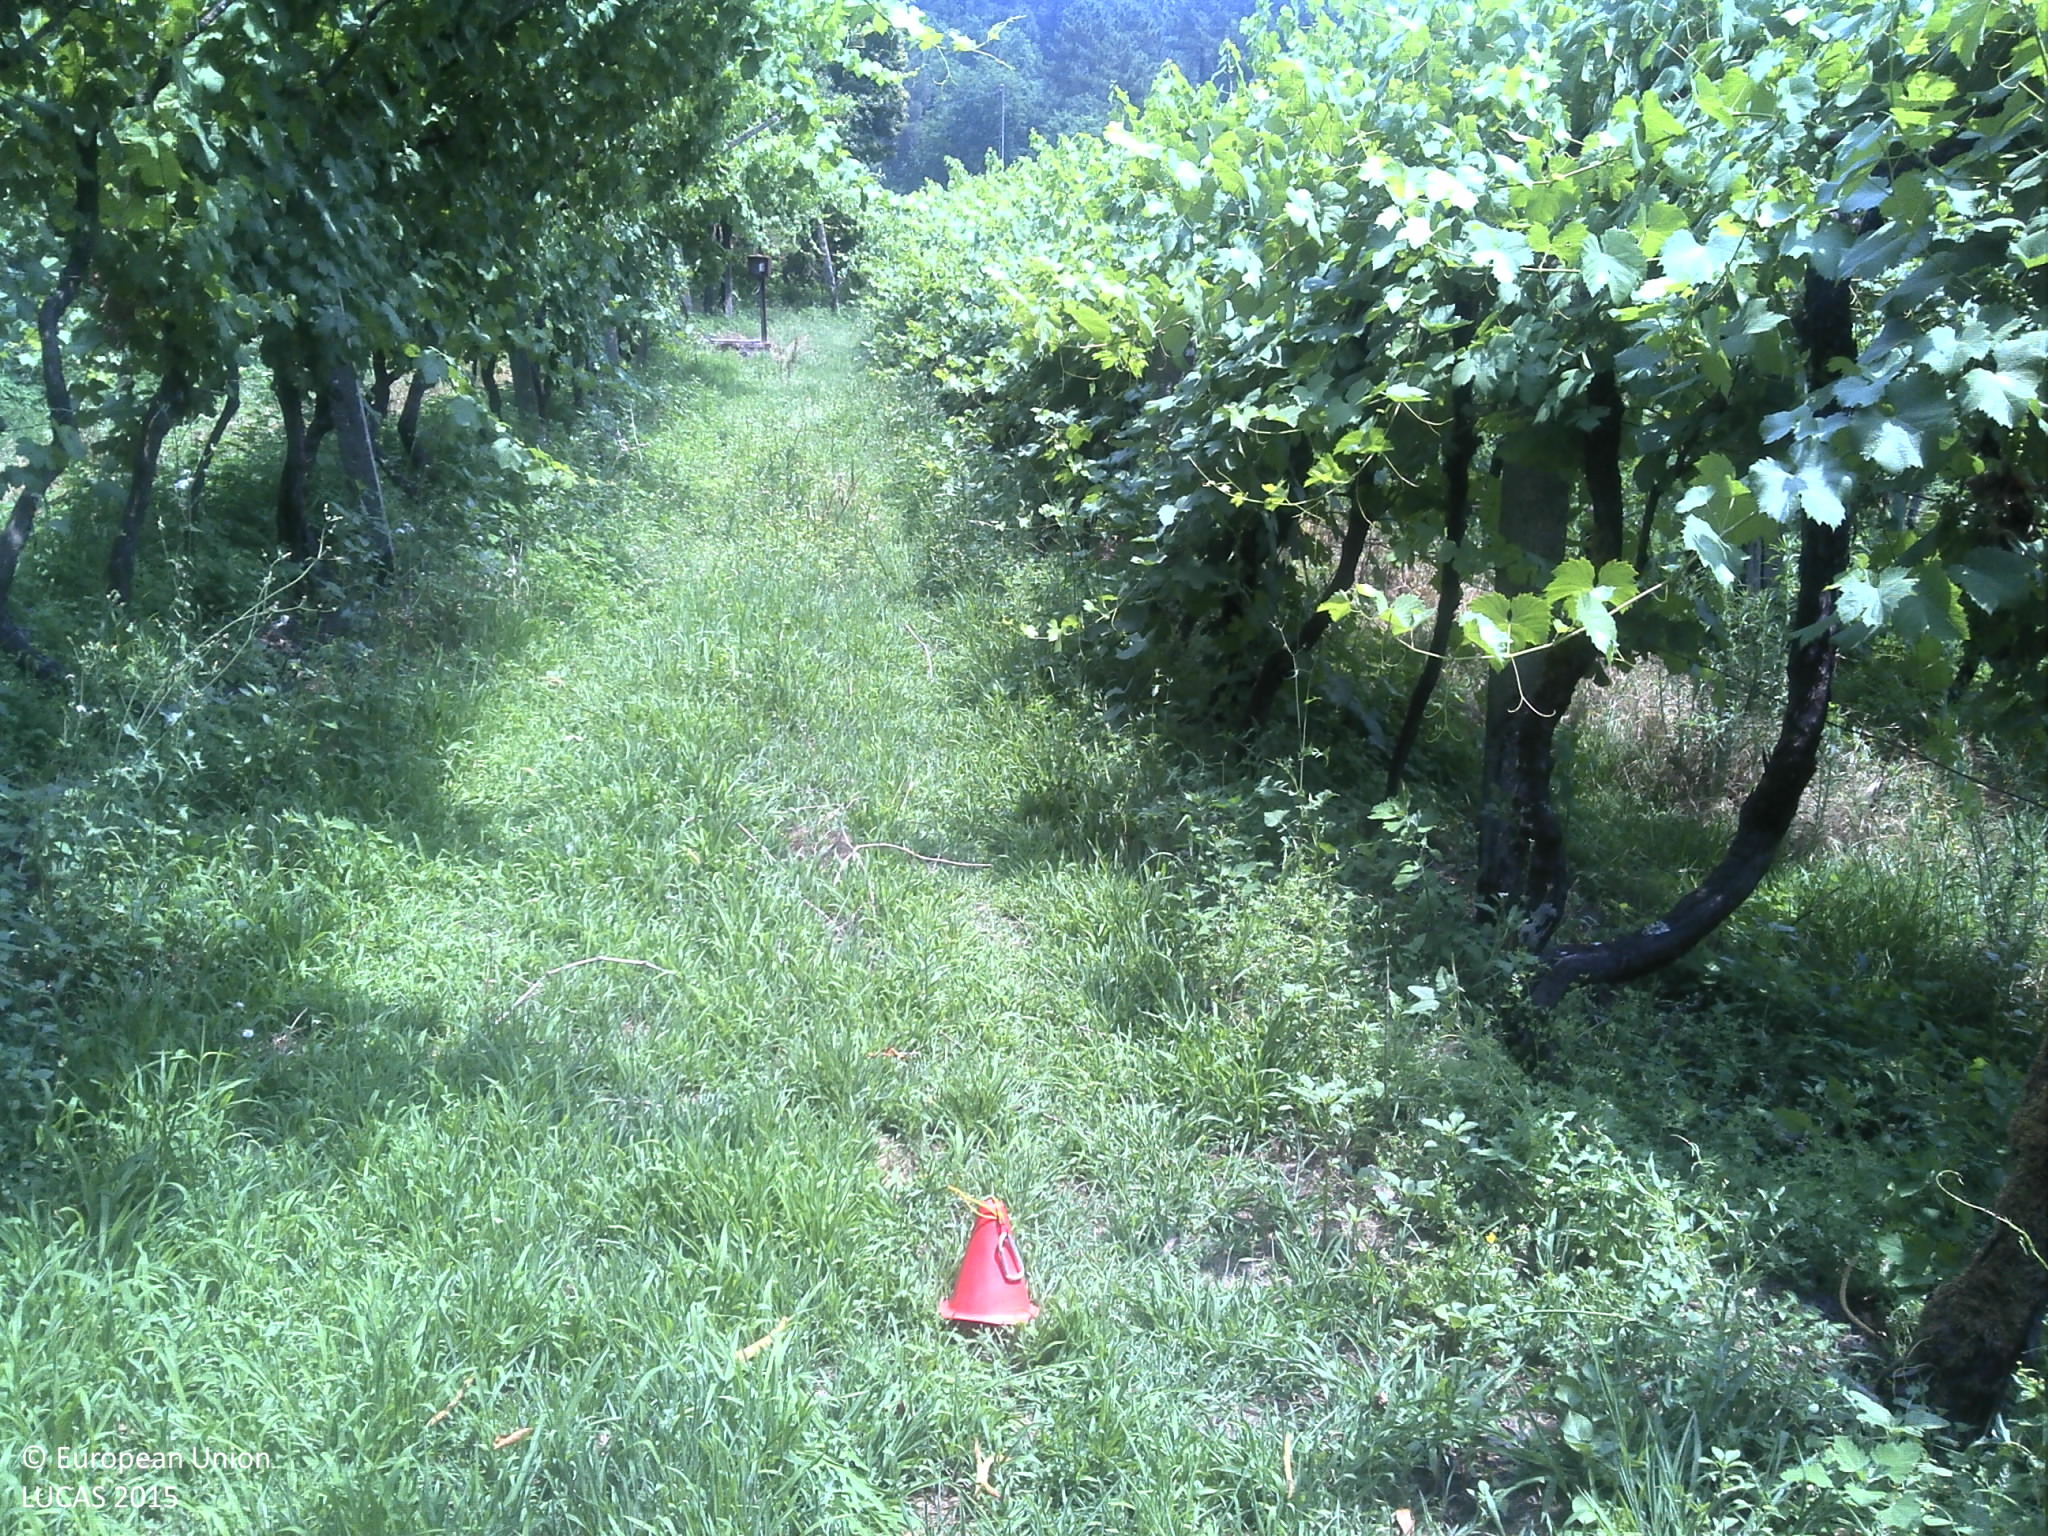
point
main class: Cropland
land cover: Vineyards
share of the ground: 25 - 50 %
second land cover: Grassland without tree/shrub cover
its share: 50 - 75 %
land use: Agriculture (excluding fallow land and kitchen gardens)
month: June
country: PT
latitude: 41.3176
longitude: -8.2183
